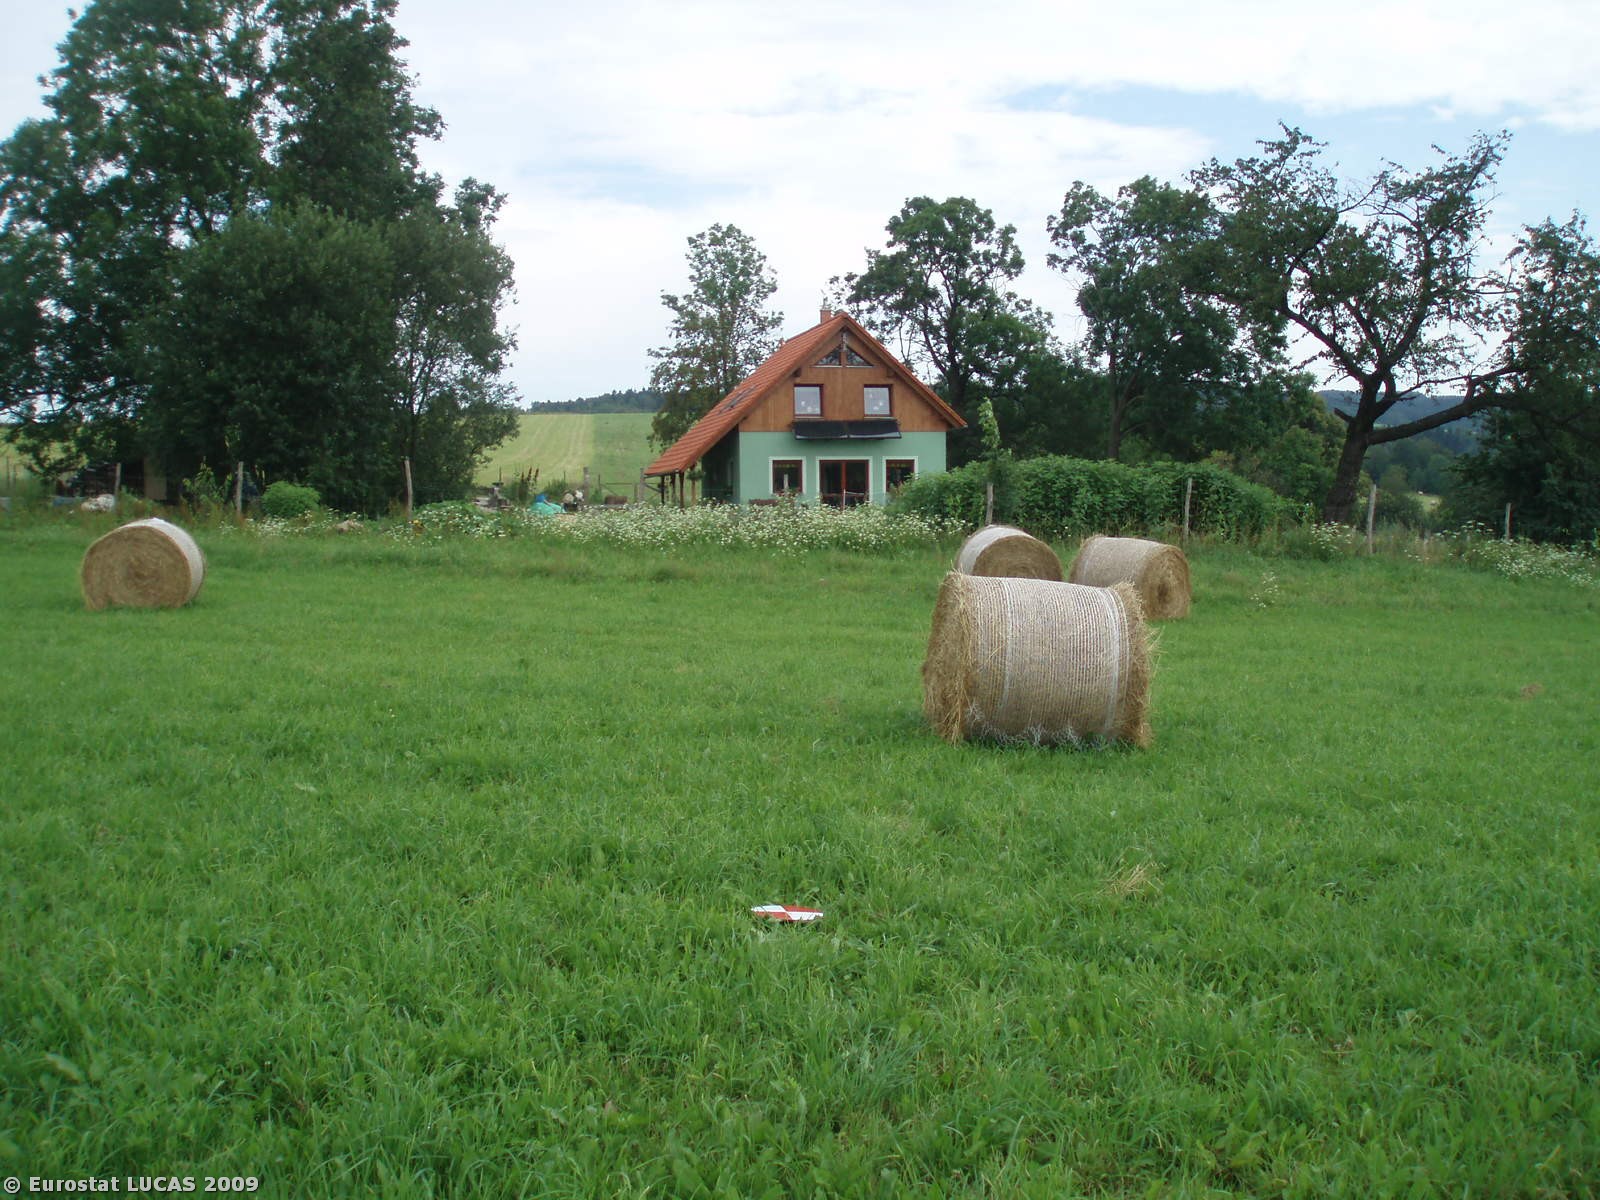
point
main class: Grassland
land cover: Grassland without tree/shrub cover
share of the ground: > 75 %
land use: Agriculture (excluding fallow land and kitchen gardens)
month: July
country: CZ
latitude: 50.8318
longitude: 14.9865
